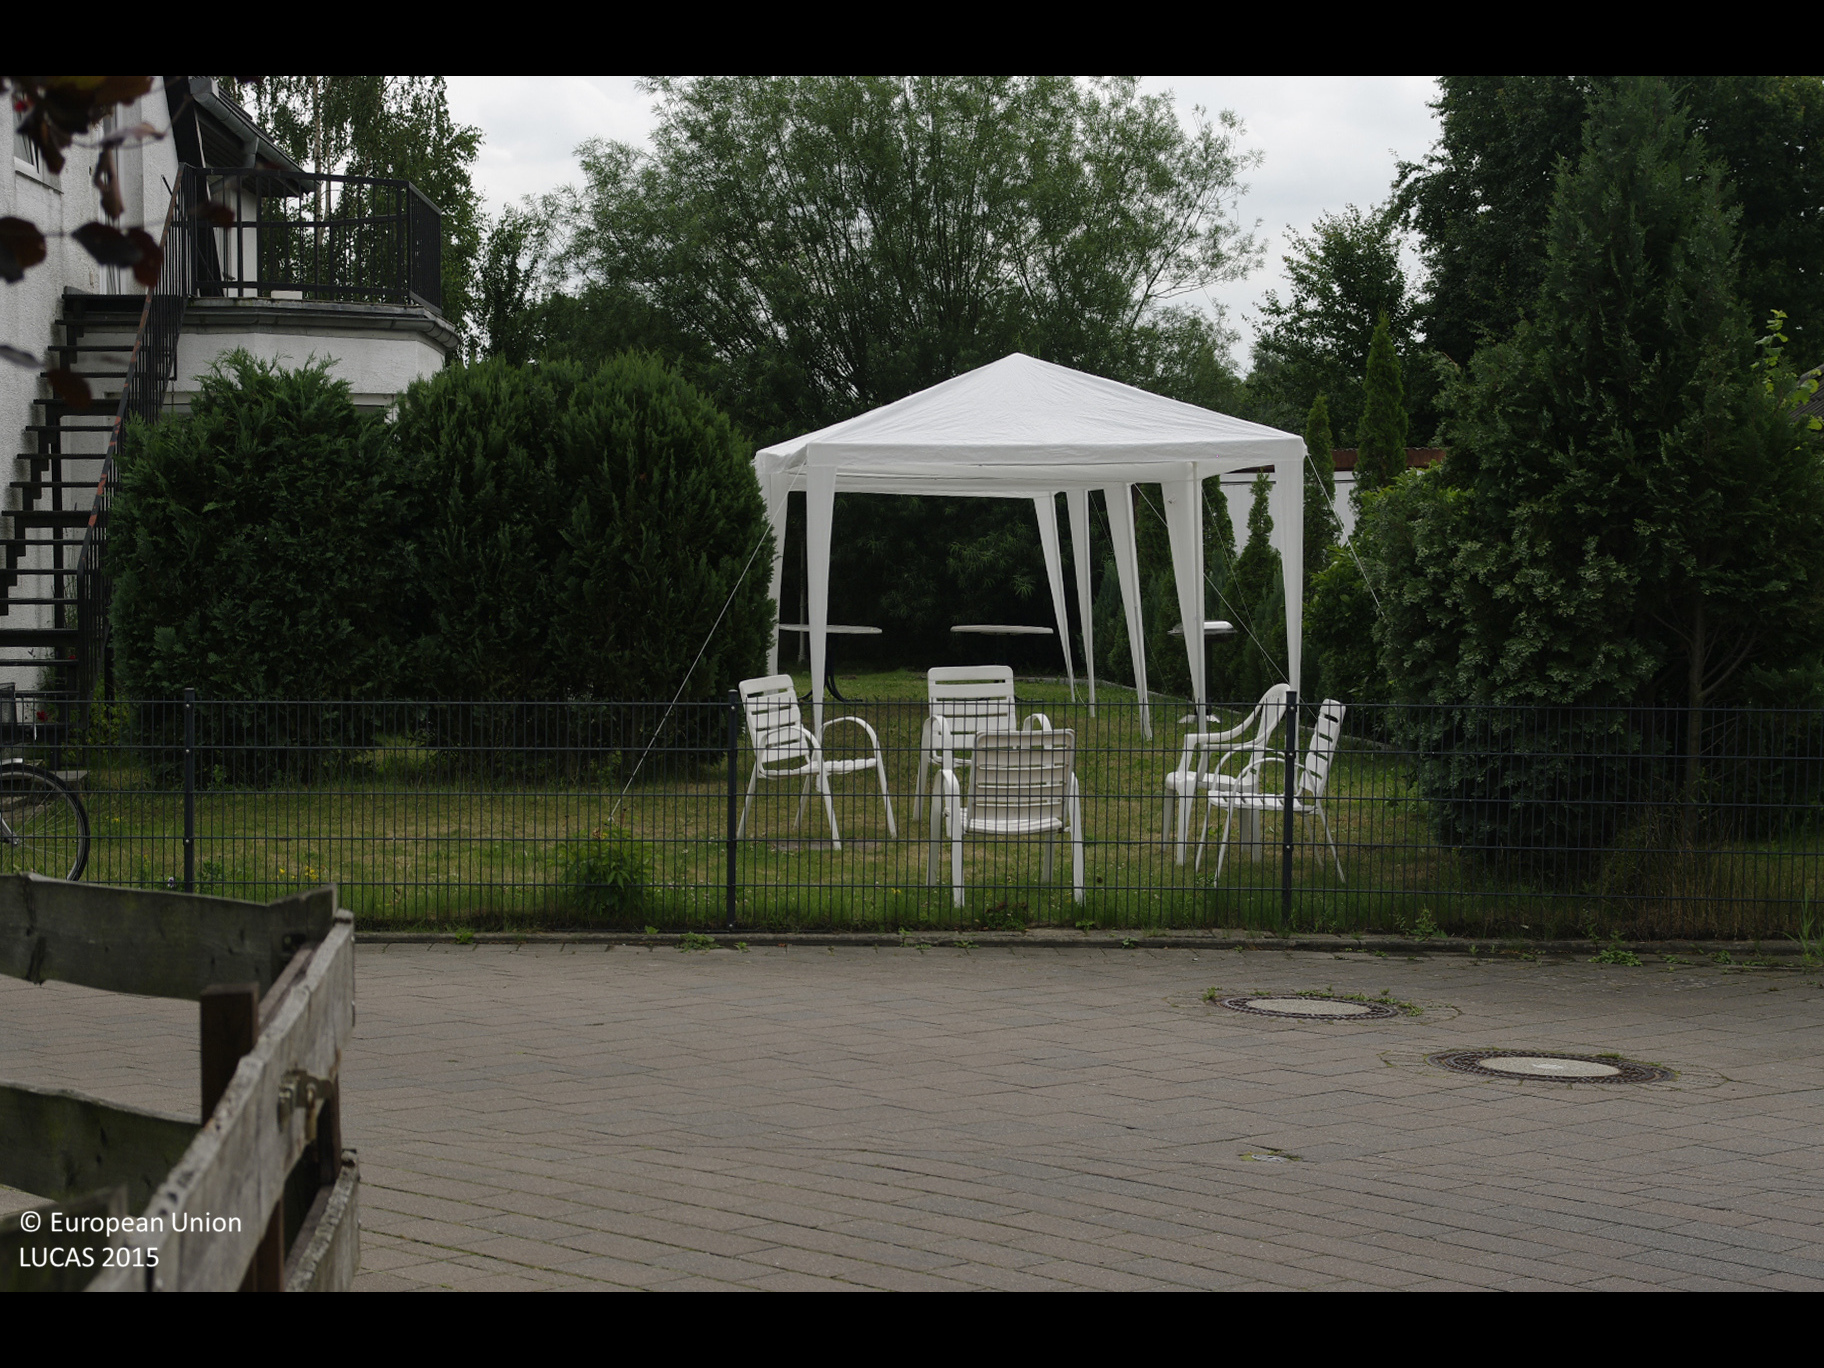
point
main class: Grassland
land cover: Grassland without tree/shrub cover
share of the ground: > 75 %
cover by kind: herbaceous plants 100 %
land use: Residential
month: July
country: DE
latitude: 53.4914
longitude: 10.3164
